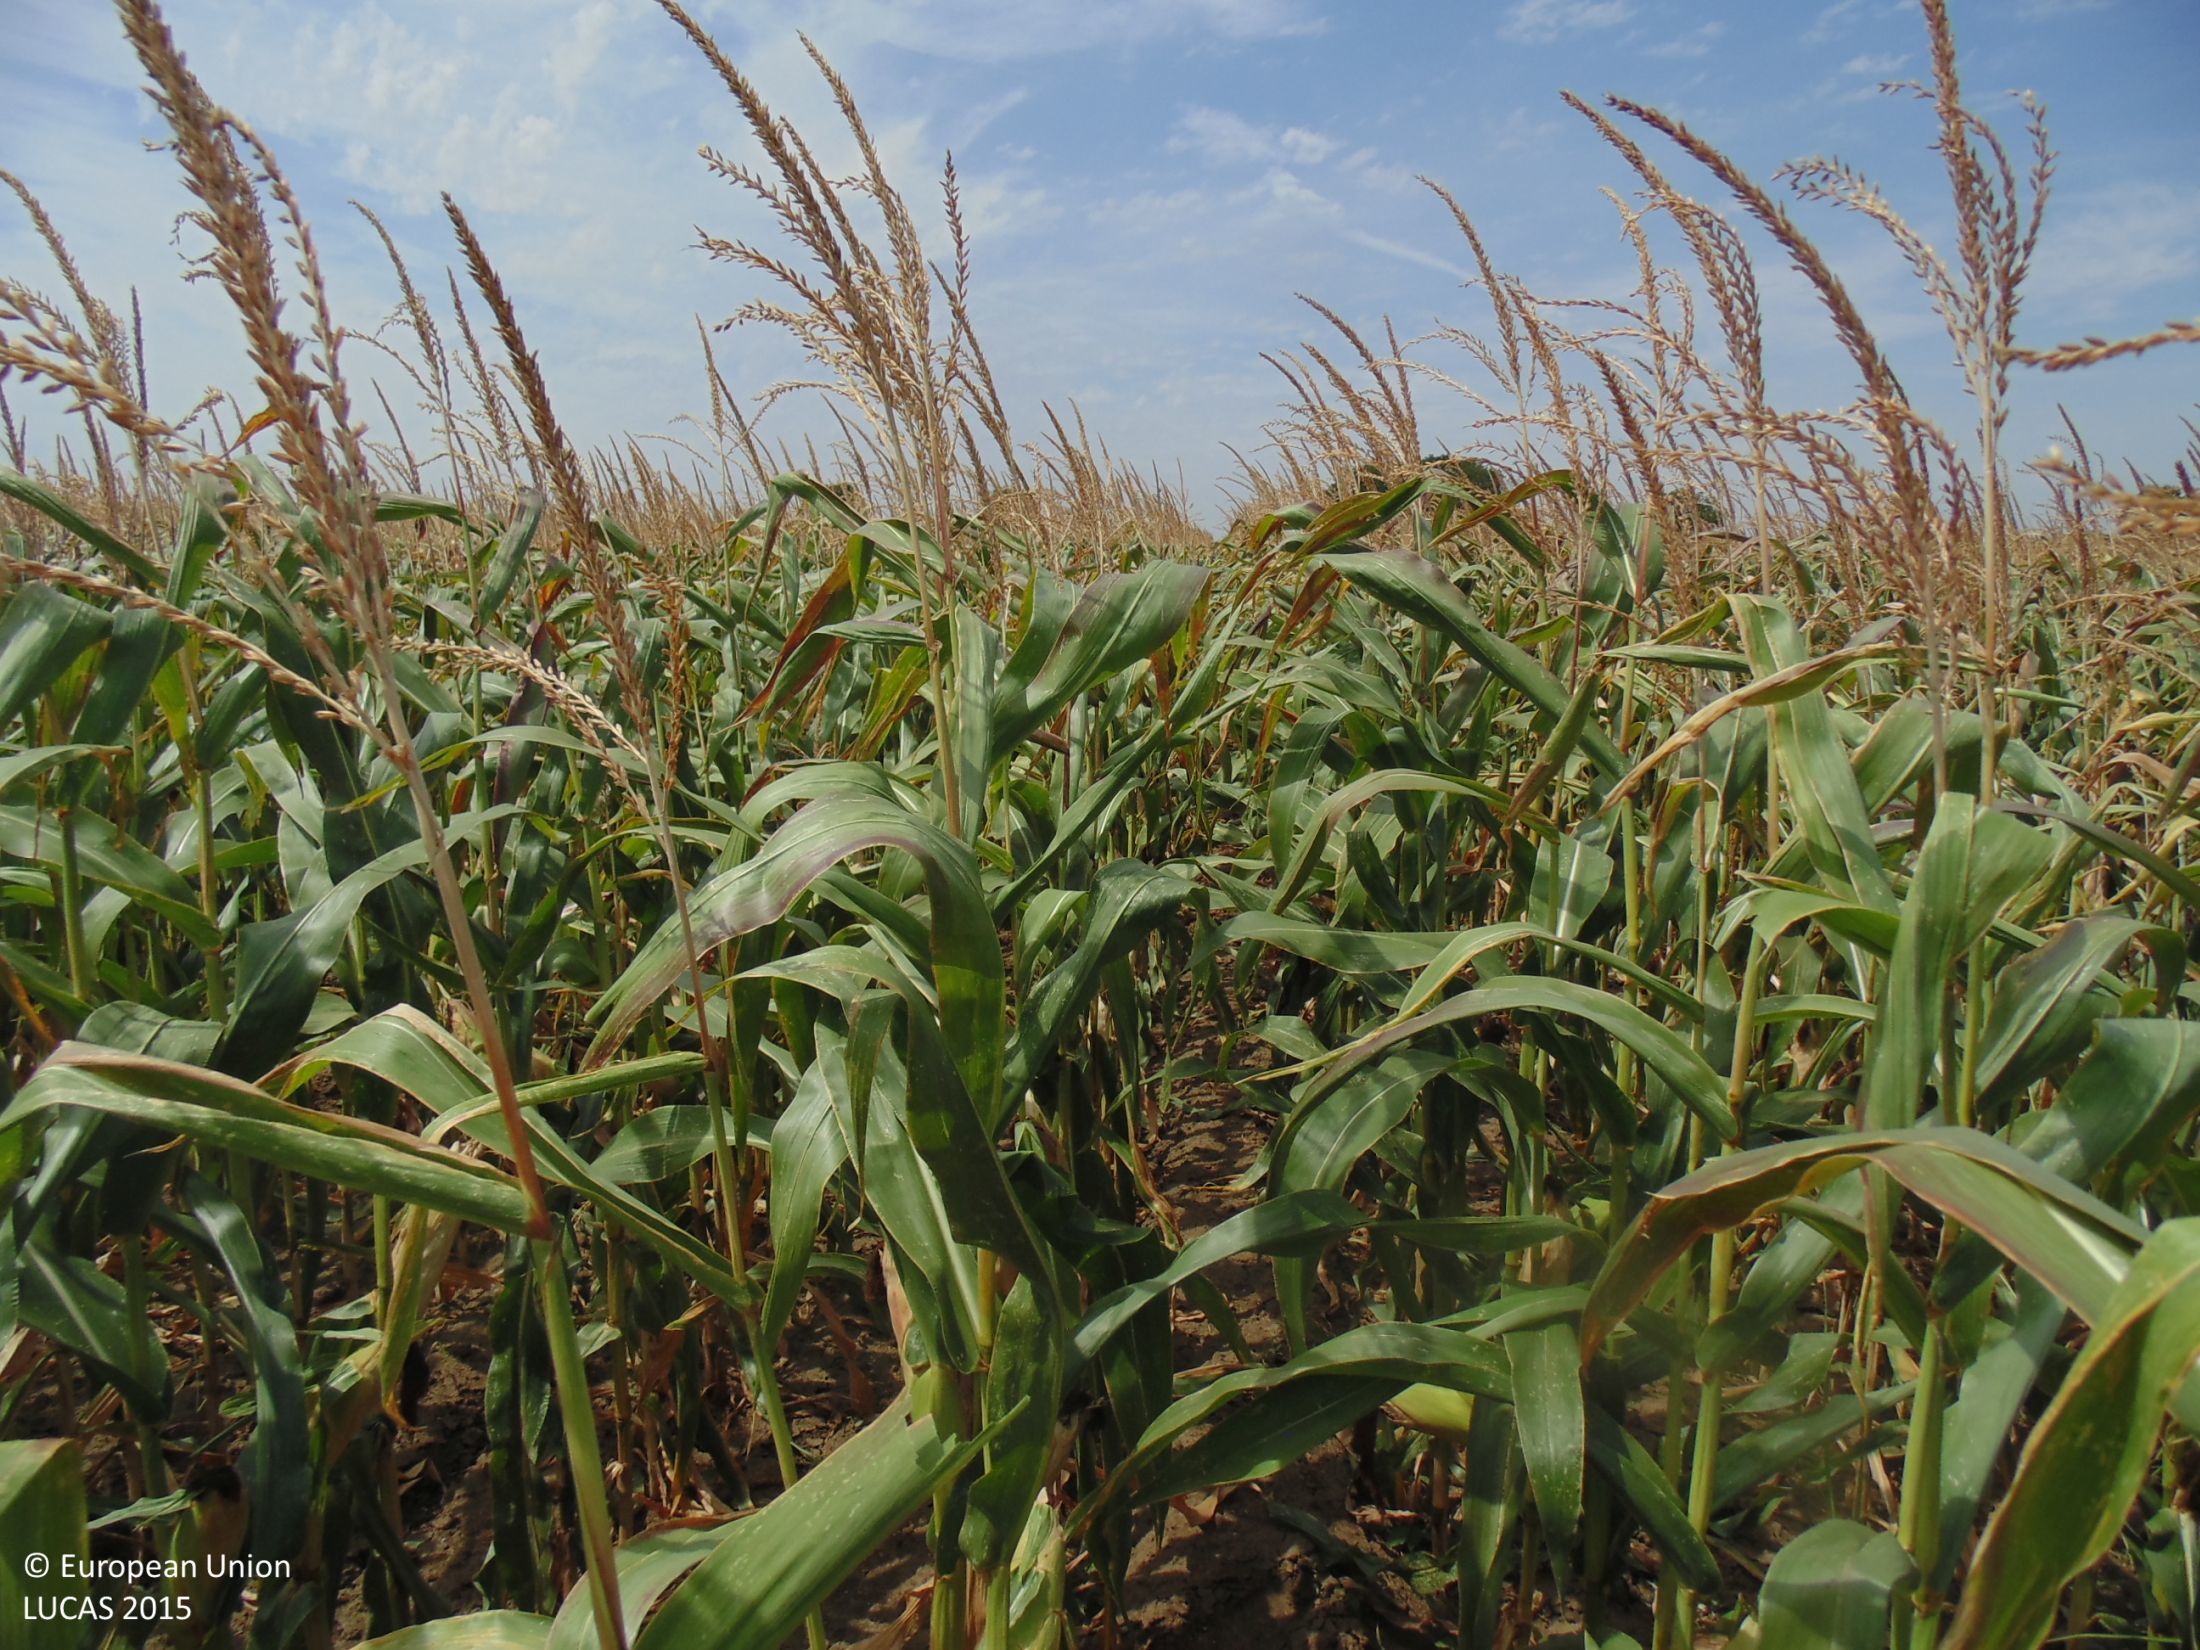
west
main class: Cropland
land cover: Maize
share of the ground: > 75 %
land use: Agriculture (excluding fallow land and kitchen gardens)
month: August
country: BG
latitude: 43.7133
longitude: 28.5464
